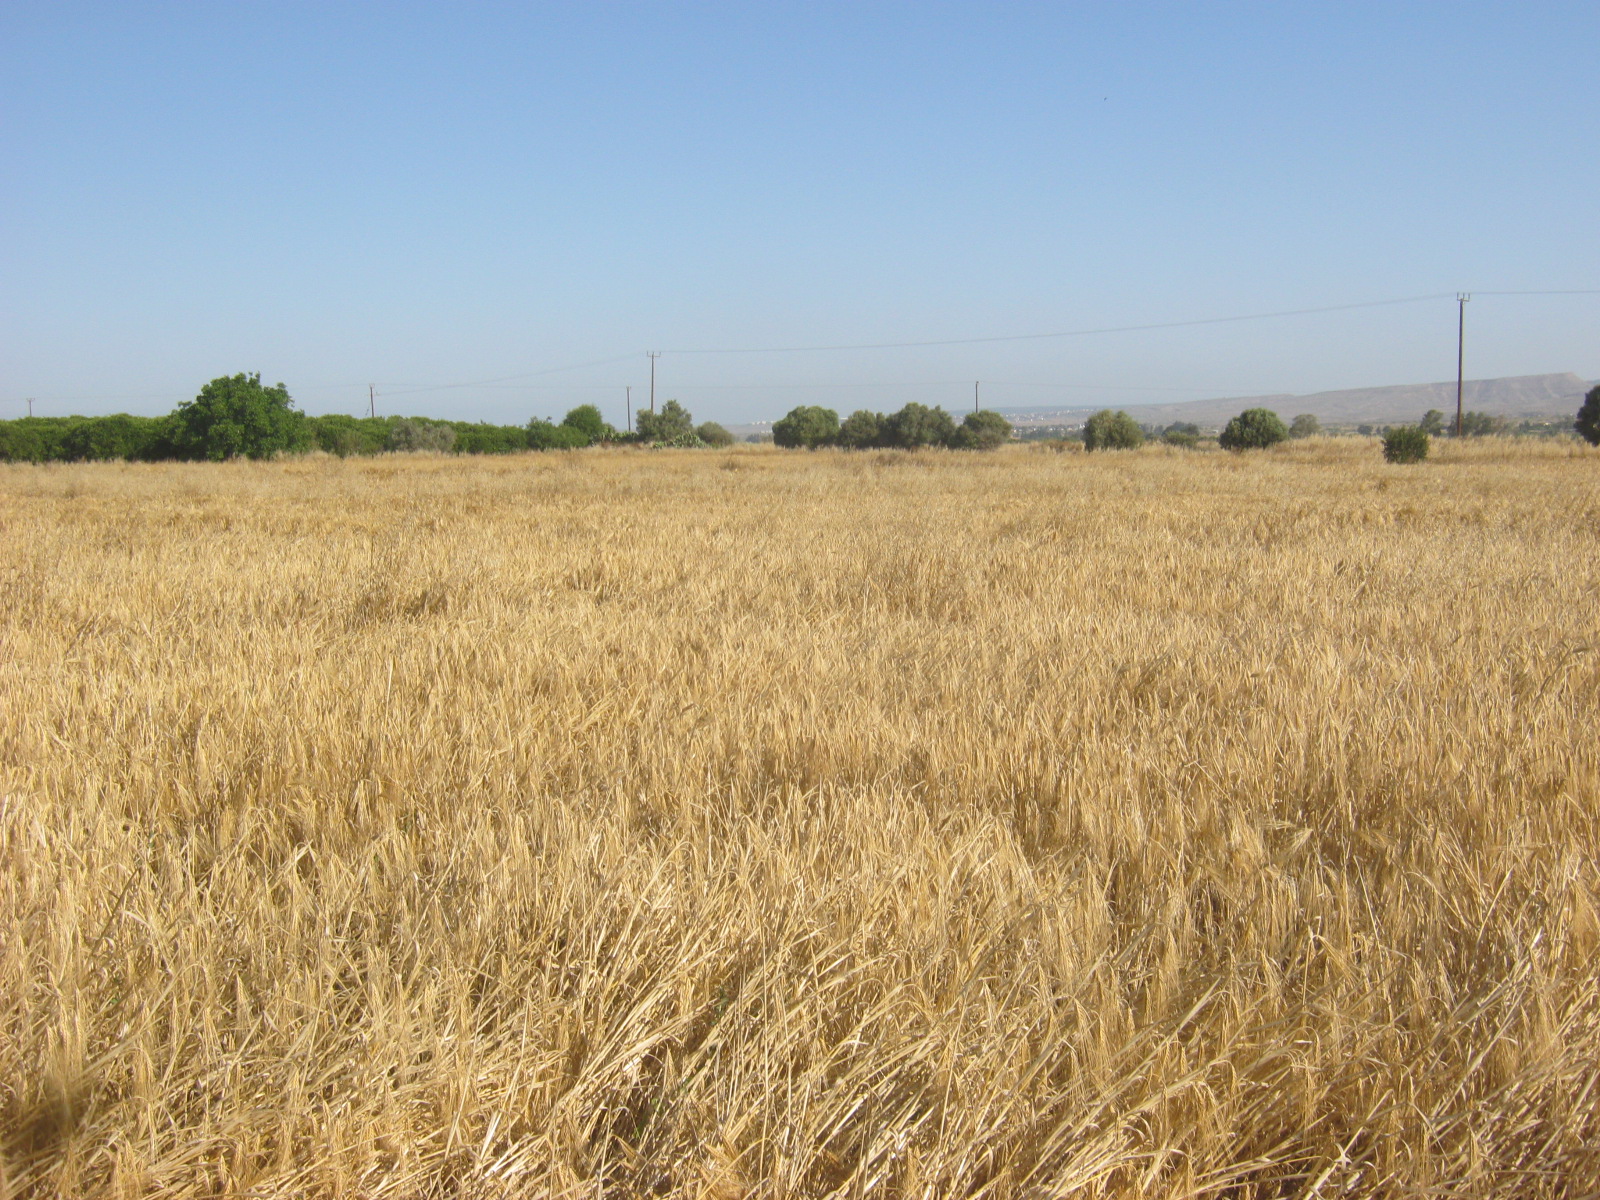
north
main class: Cropland
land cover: Barley
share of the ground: > 75 %
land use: Agriculture (excluding fallow land and kitchen gardens)
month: May
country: CY
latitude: 35.1688
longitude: 33.0744
